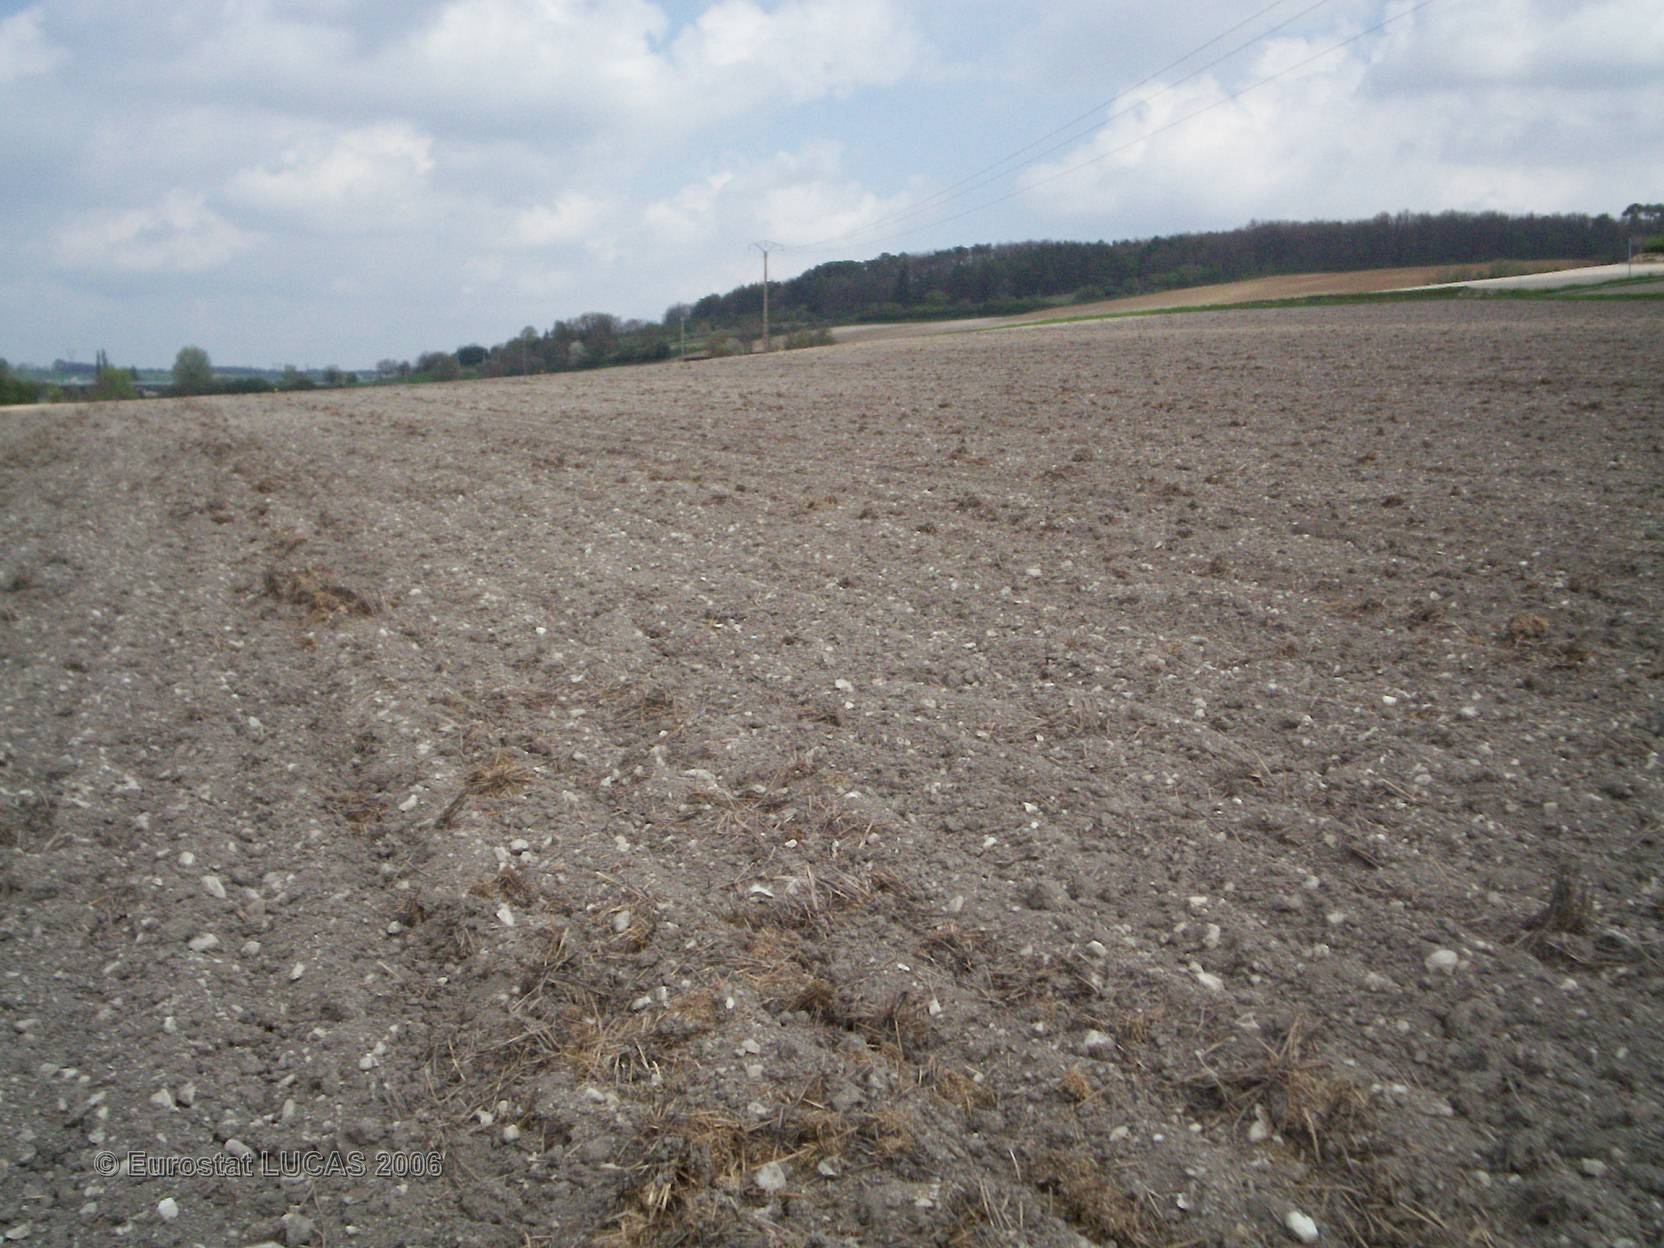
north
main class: Bare land
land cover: Bare land
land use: Agriculture (excluding fallow land and kitchen gardens)
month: April
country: FR
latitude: 46.8721
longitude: 0.5217
